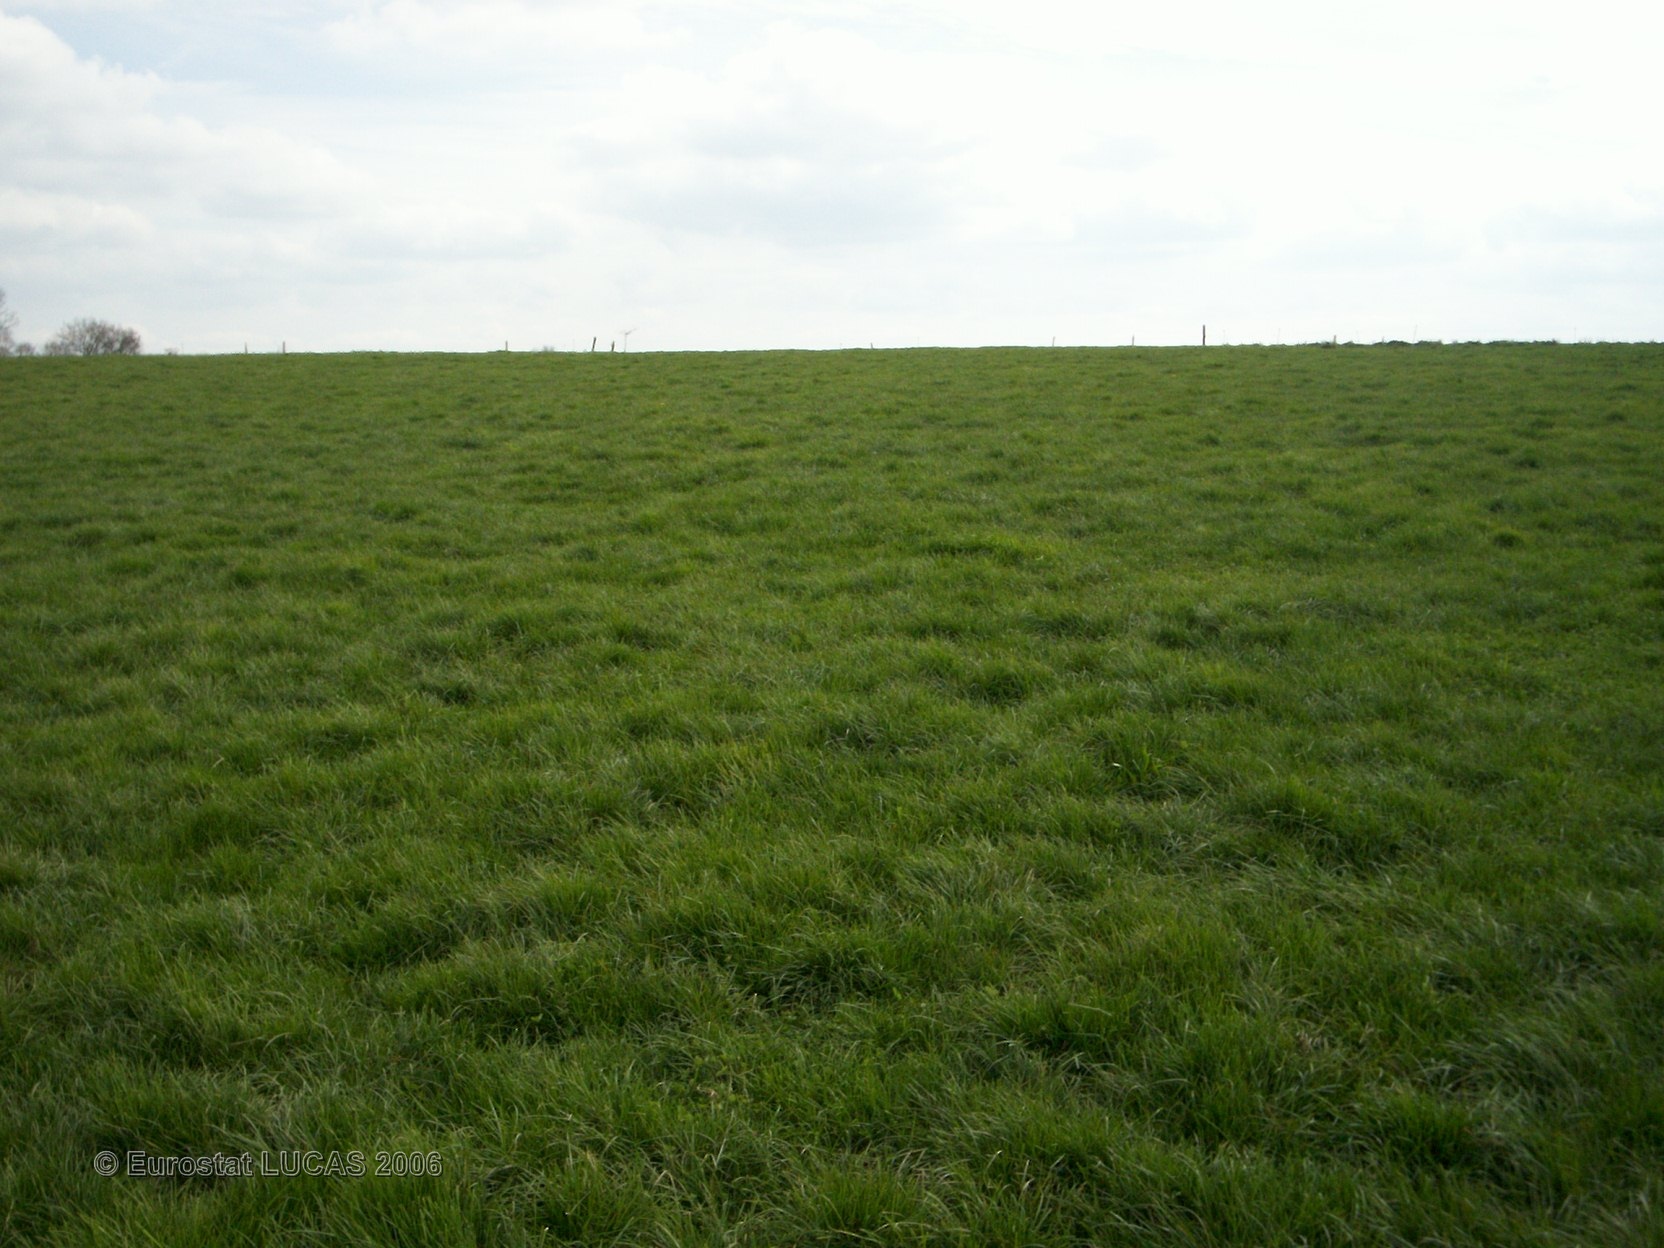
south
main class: Grassland
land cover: Grassland without tree/shrub cover
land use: Agriculture (excluding fallow land and kitchen gardens)
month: April
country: FR
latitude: 47.9390
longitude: -1.5719
